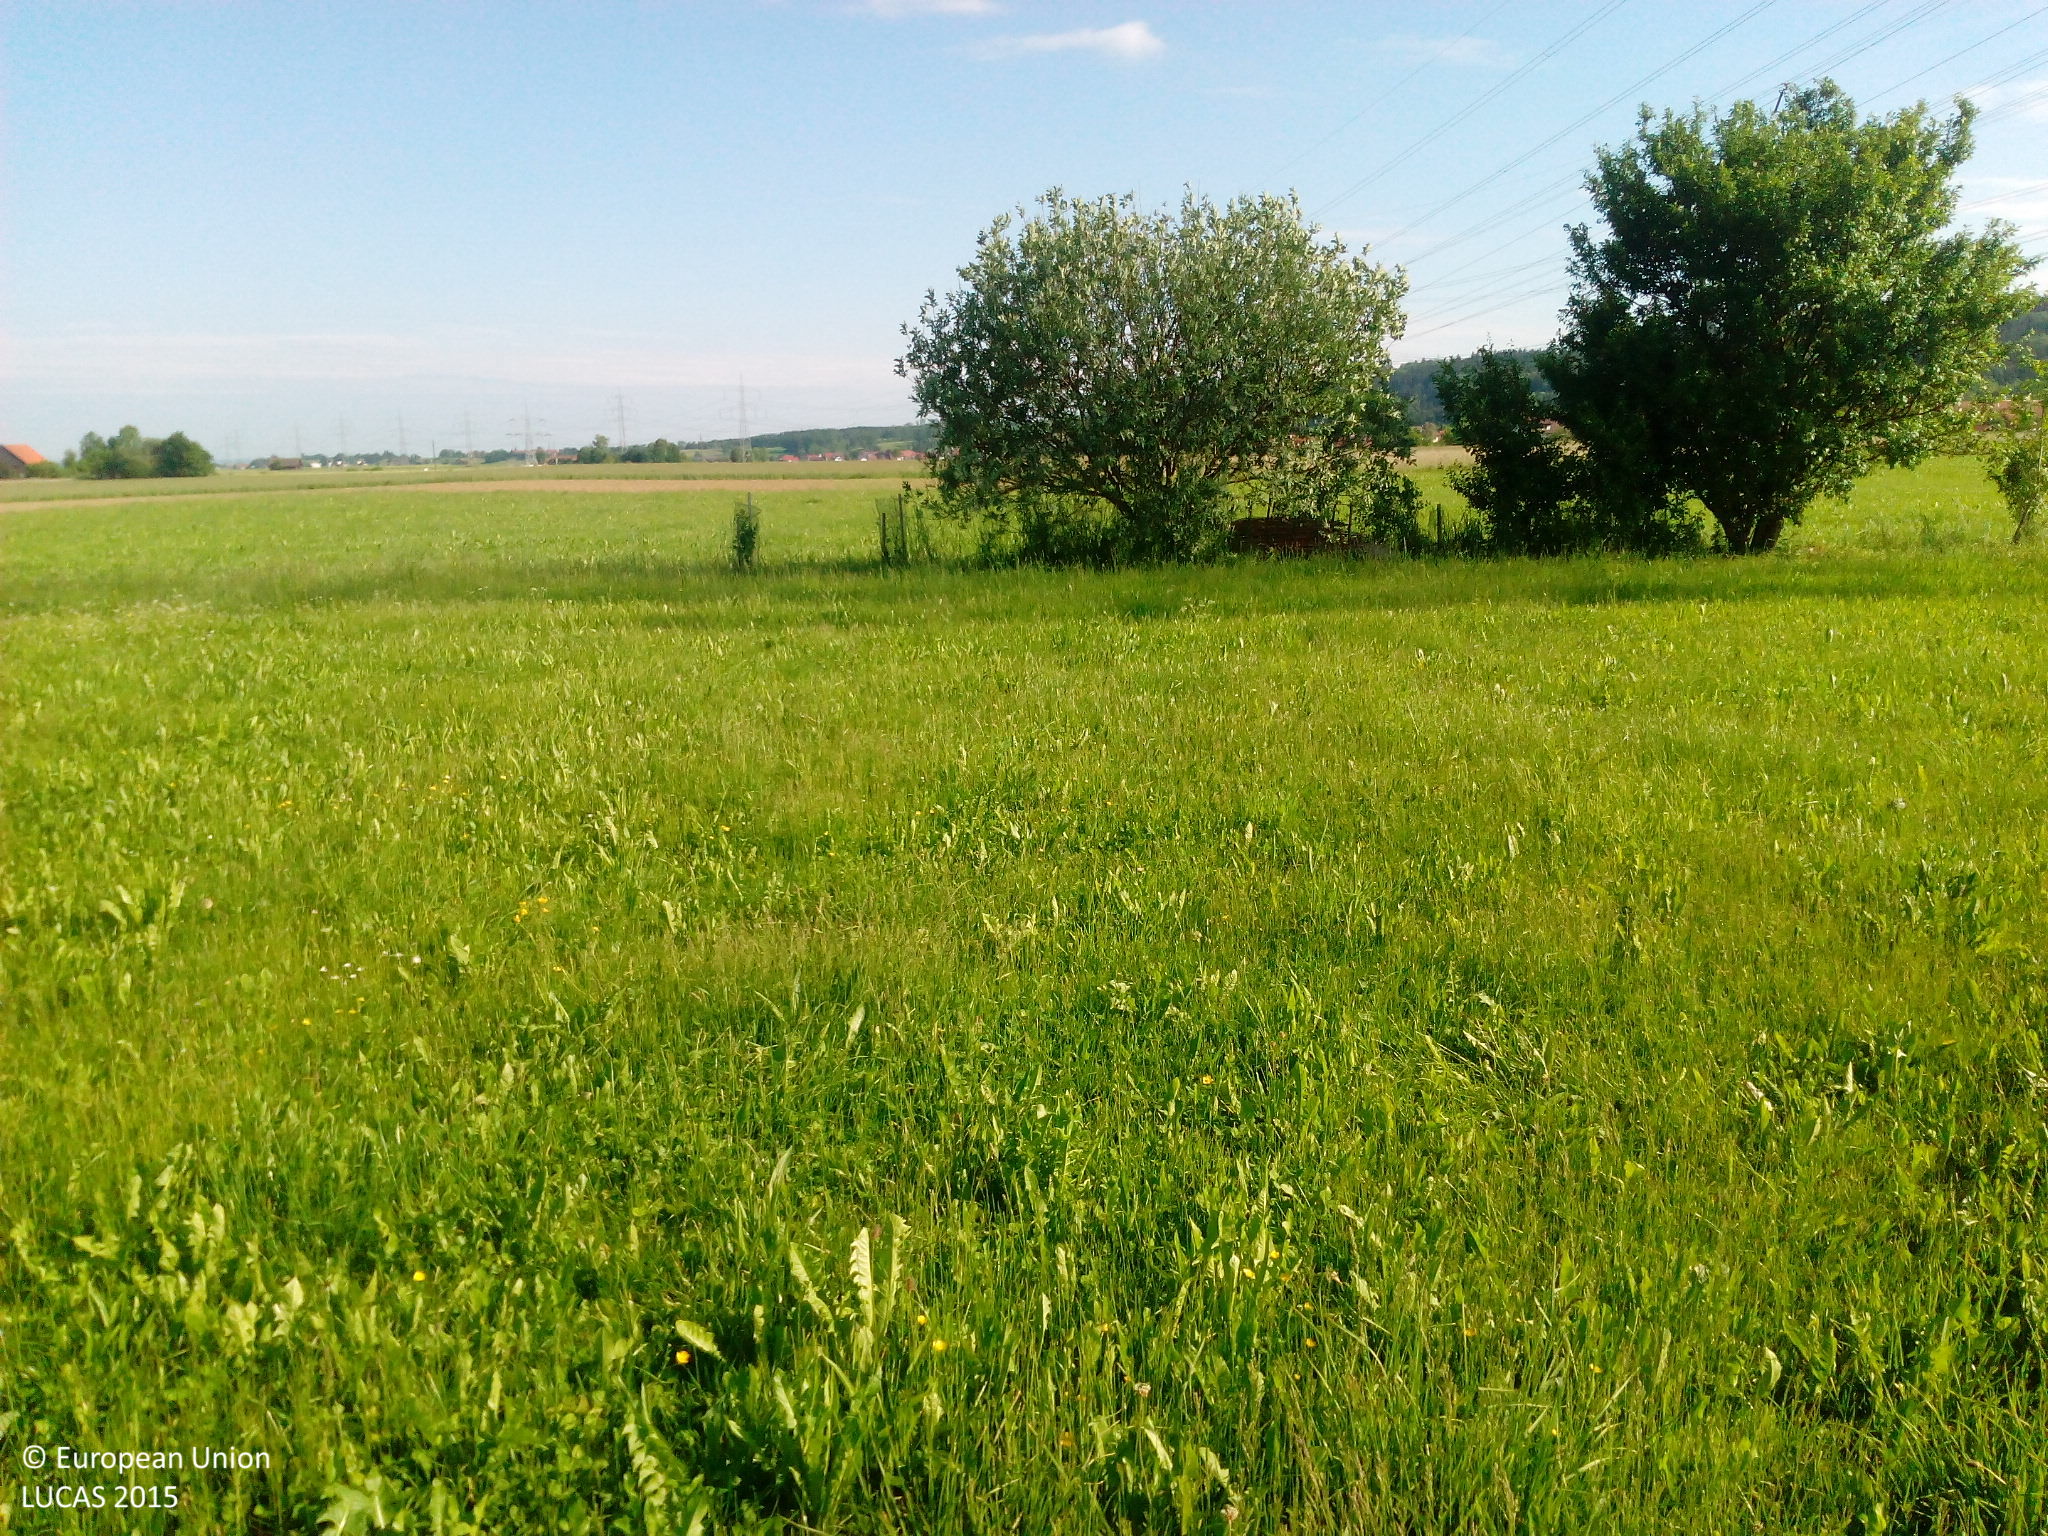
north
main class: Grassland
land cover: Grassland without tree/shrub cover
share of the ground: > 75 %
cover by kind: herbaceous plants 100 %
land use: Agriculture (excluding fallow land and kitchen gardens)
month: June
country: DE
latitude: 47.8993
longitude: 10.2540
